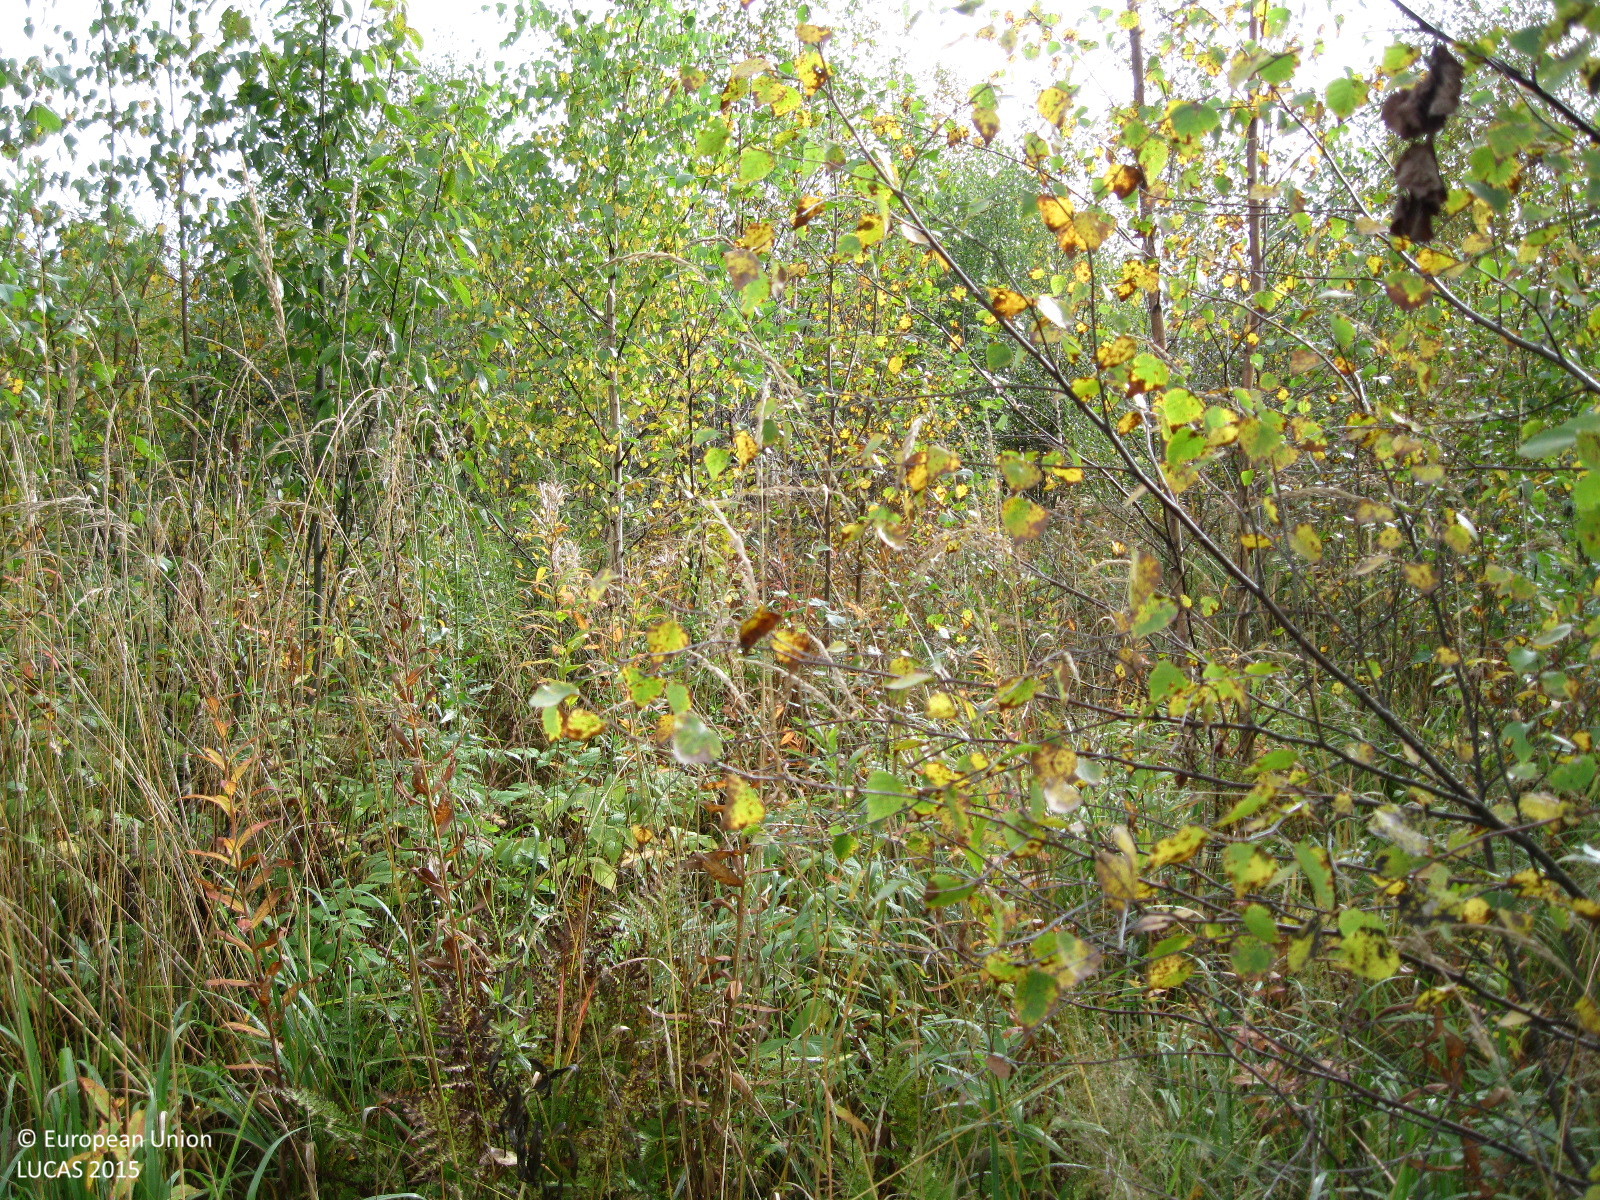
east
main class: Woodland
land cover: Broadleaved woodland
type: boreal forest
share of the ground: 50 - 75 %
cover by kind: broadleaved forest trees 65 %, herbaceous plants 25 %, coniferous forest trees 5 %, shrubs 5 %
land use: Forestry
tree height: > 5 m
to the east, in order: Broadleaved woodland; Ditches and canals; Grass margins; Barley
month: September
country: FI
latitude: 60.7910
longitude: 24.7883
